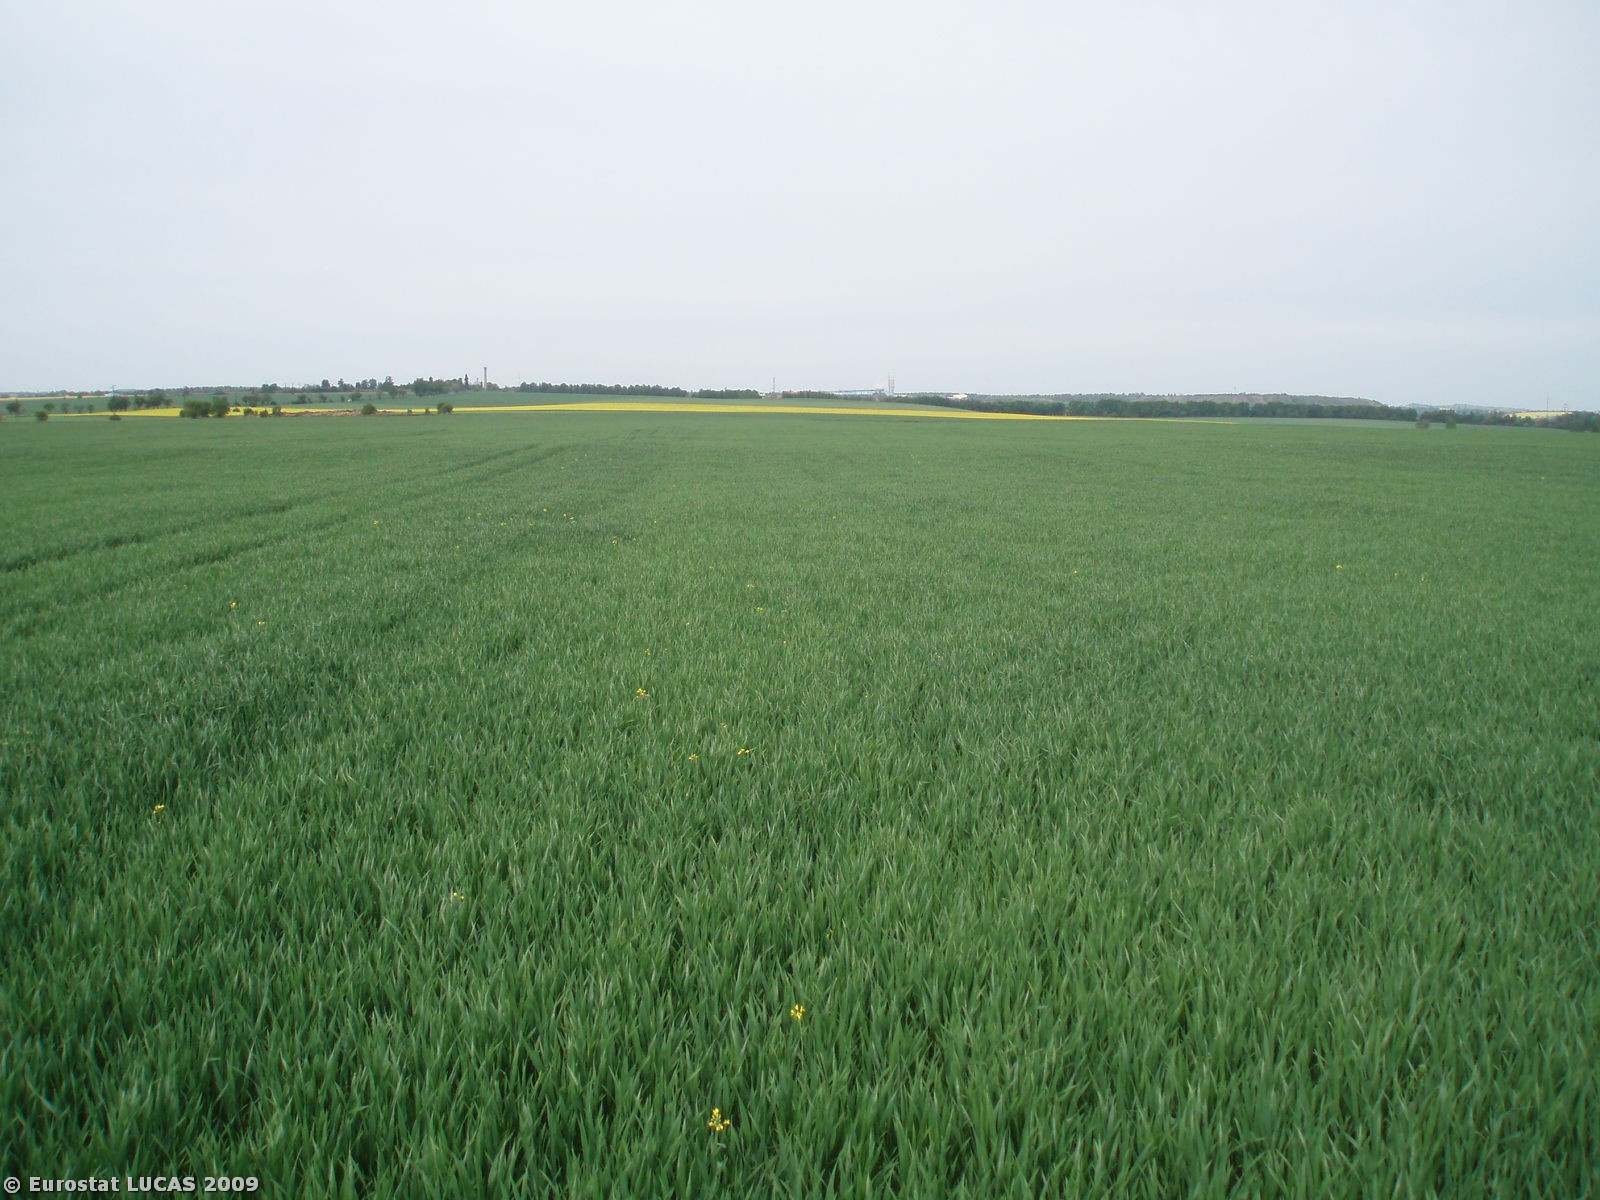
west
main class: Cropland
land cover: Common wheat
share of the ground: > 75 %
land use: Agriculture (excluding fallow land and kitchen gardens)
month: May
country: CZ
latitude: 50.1594
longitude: 14.2425
